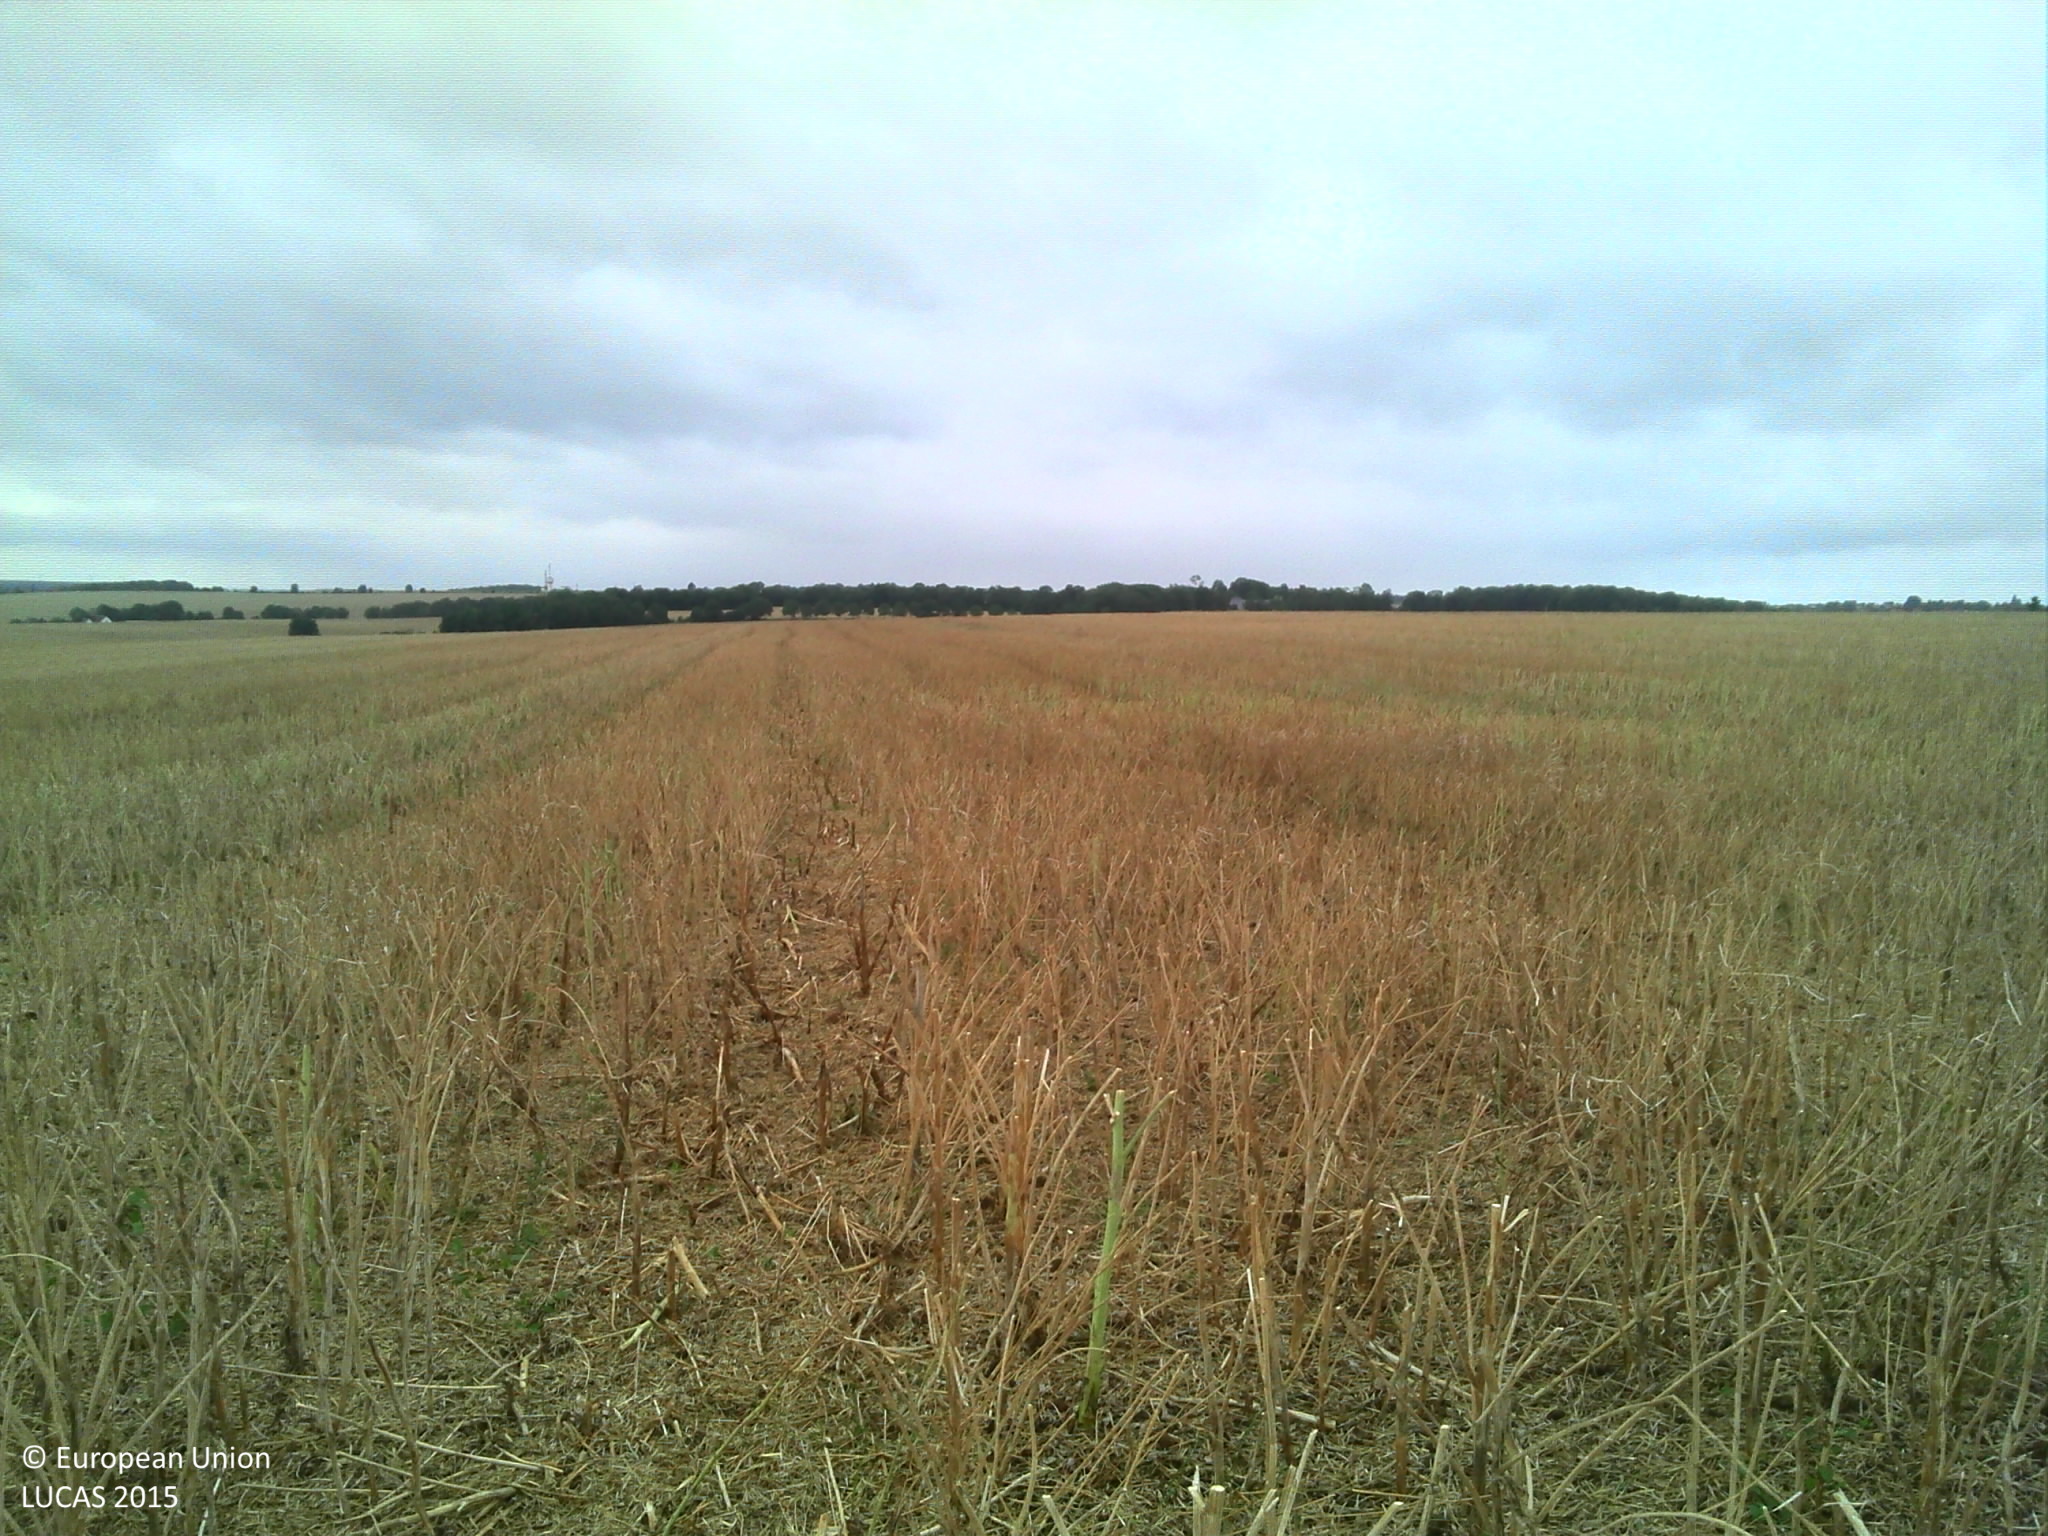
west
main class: Cropland
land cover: Rape and turnip rape
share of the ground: 25 - 50 %
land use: Agriculture (excluding fallow land and kitchen gardens)
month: July
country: FR
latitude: 49.8283
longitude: 2.4948
